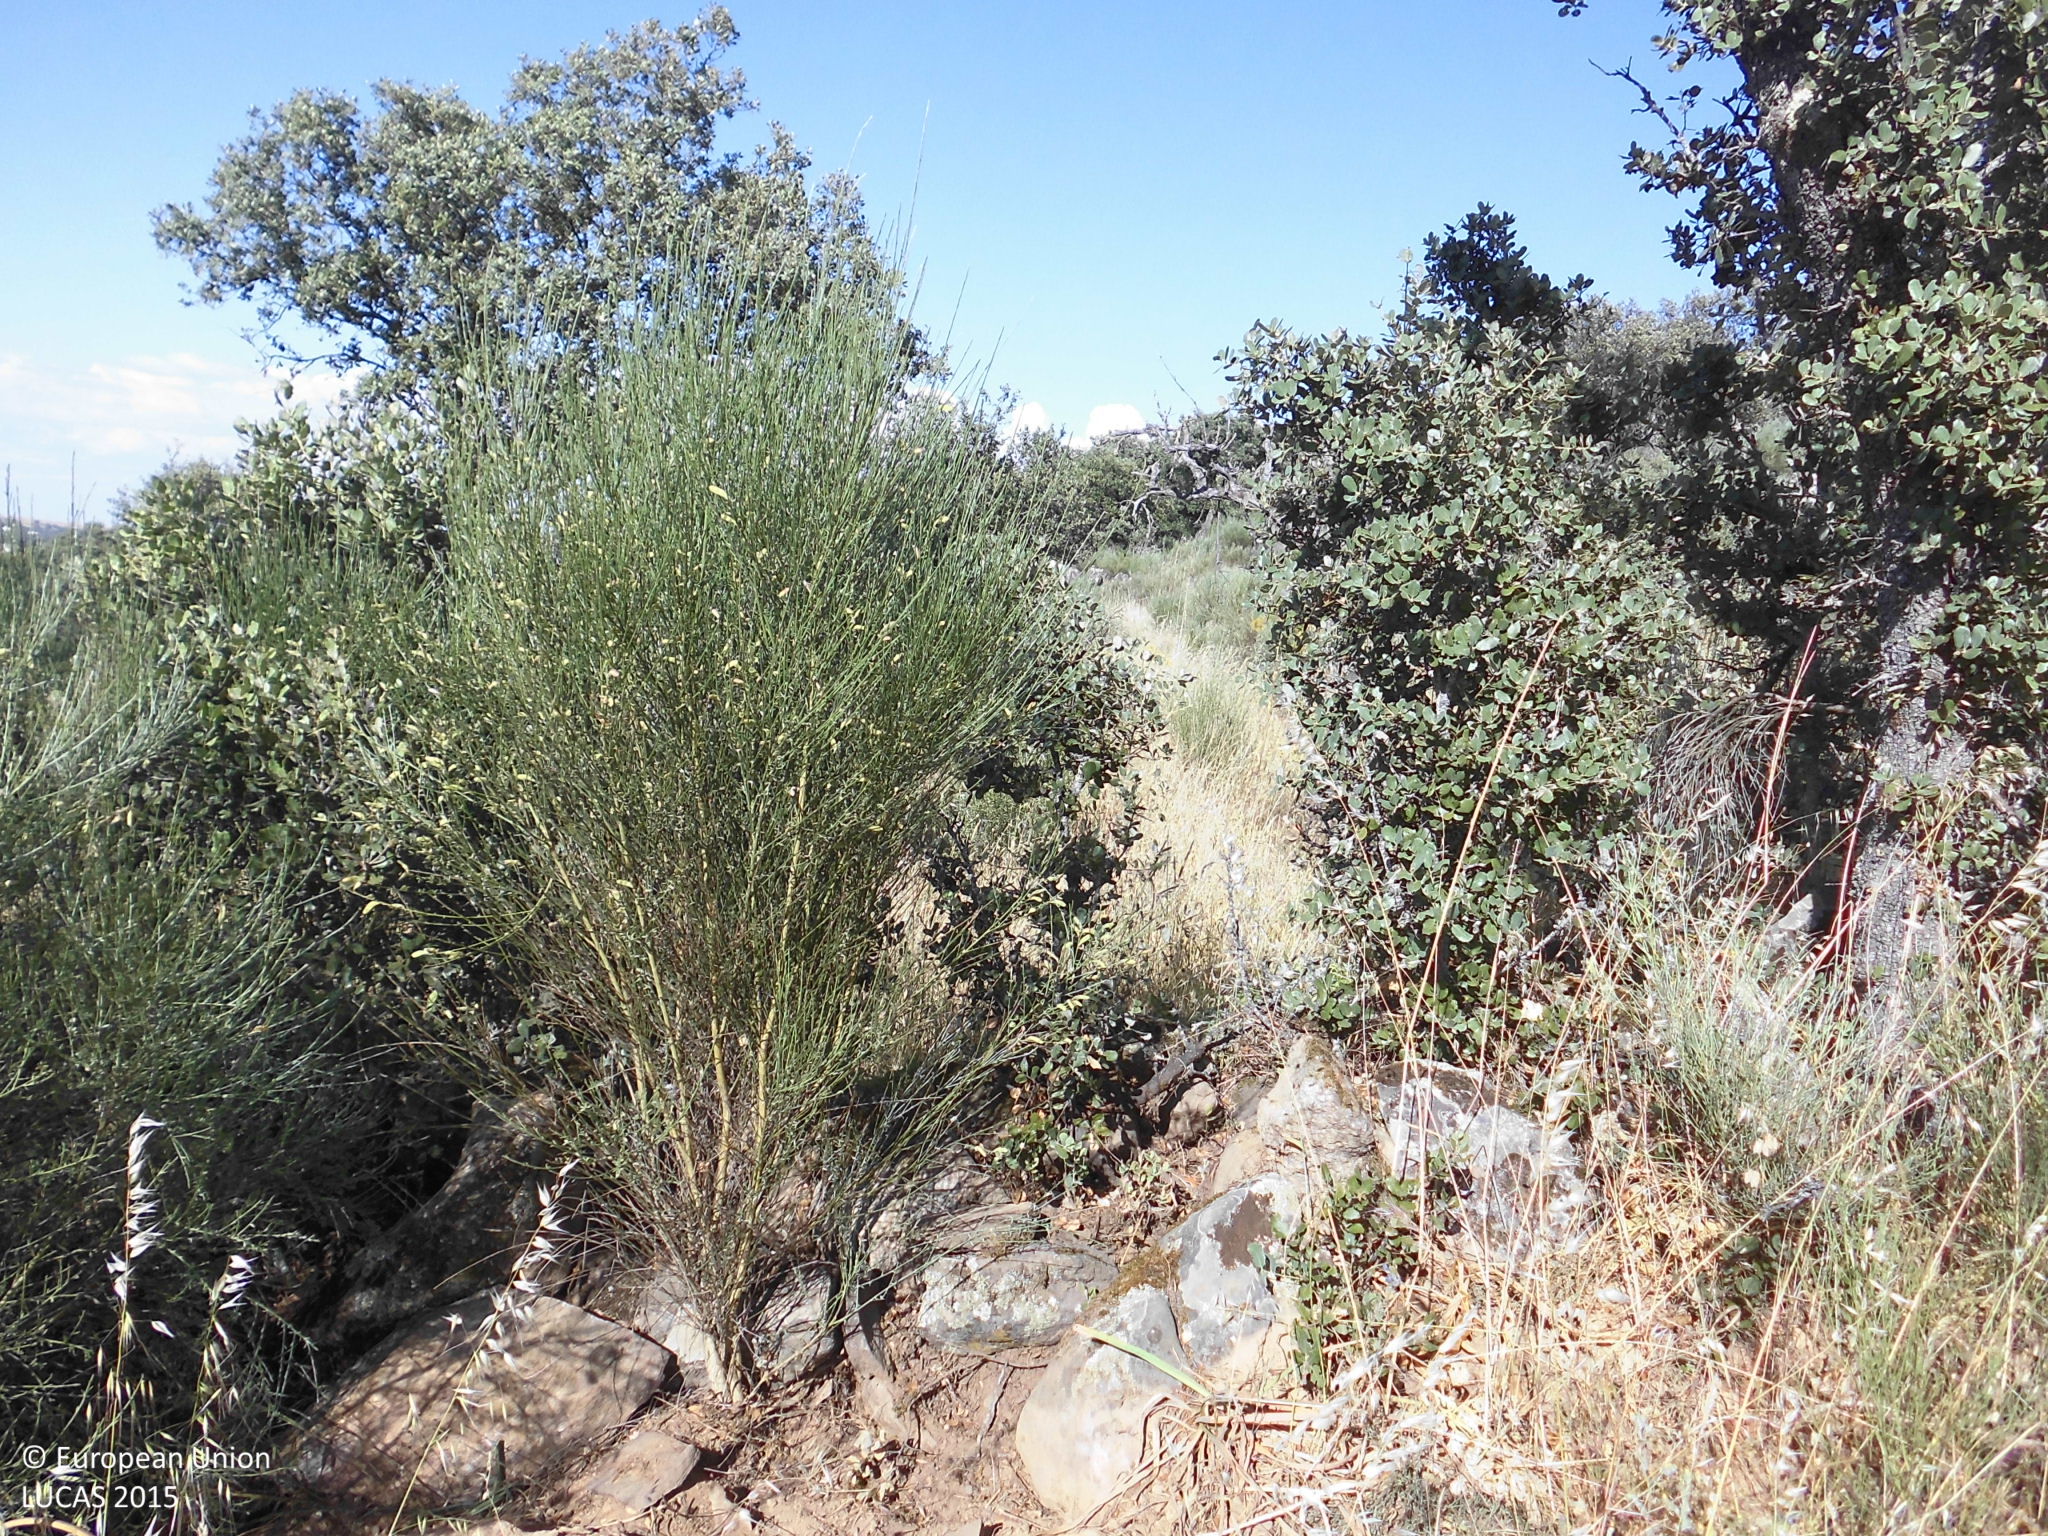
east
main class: Woodland
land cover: Broadleaved woodland
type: broadleaved evergreen forest
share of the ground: 25 - 50 %
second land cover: Grassland without tree/shrub cover
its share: > 75 %
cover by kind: herbaceous plants 50 %, broadleaved forest trees 30 %, shrubs 20 %
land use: Forestry
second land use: Agriculture (excluding fallow land and kitchen gardens)
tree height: > 5 m
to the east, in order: Broadleaved woodland; Grassland without tree/shrub cover; Rock outcrops; Broadleaved woodland; Dry stone walls; Rock outcrops; Broadleaved woodland
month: May
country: ES
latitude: 39.4318
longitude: -6.0585
